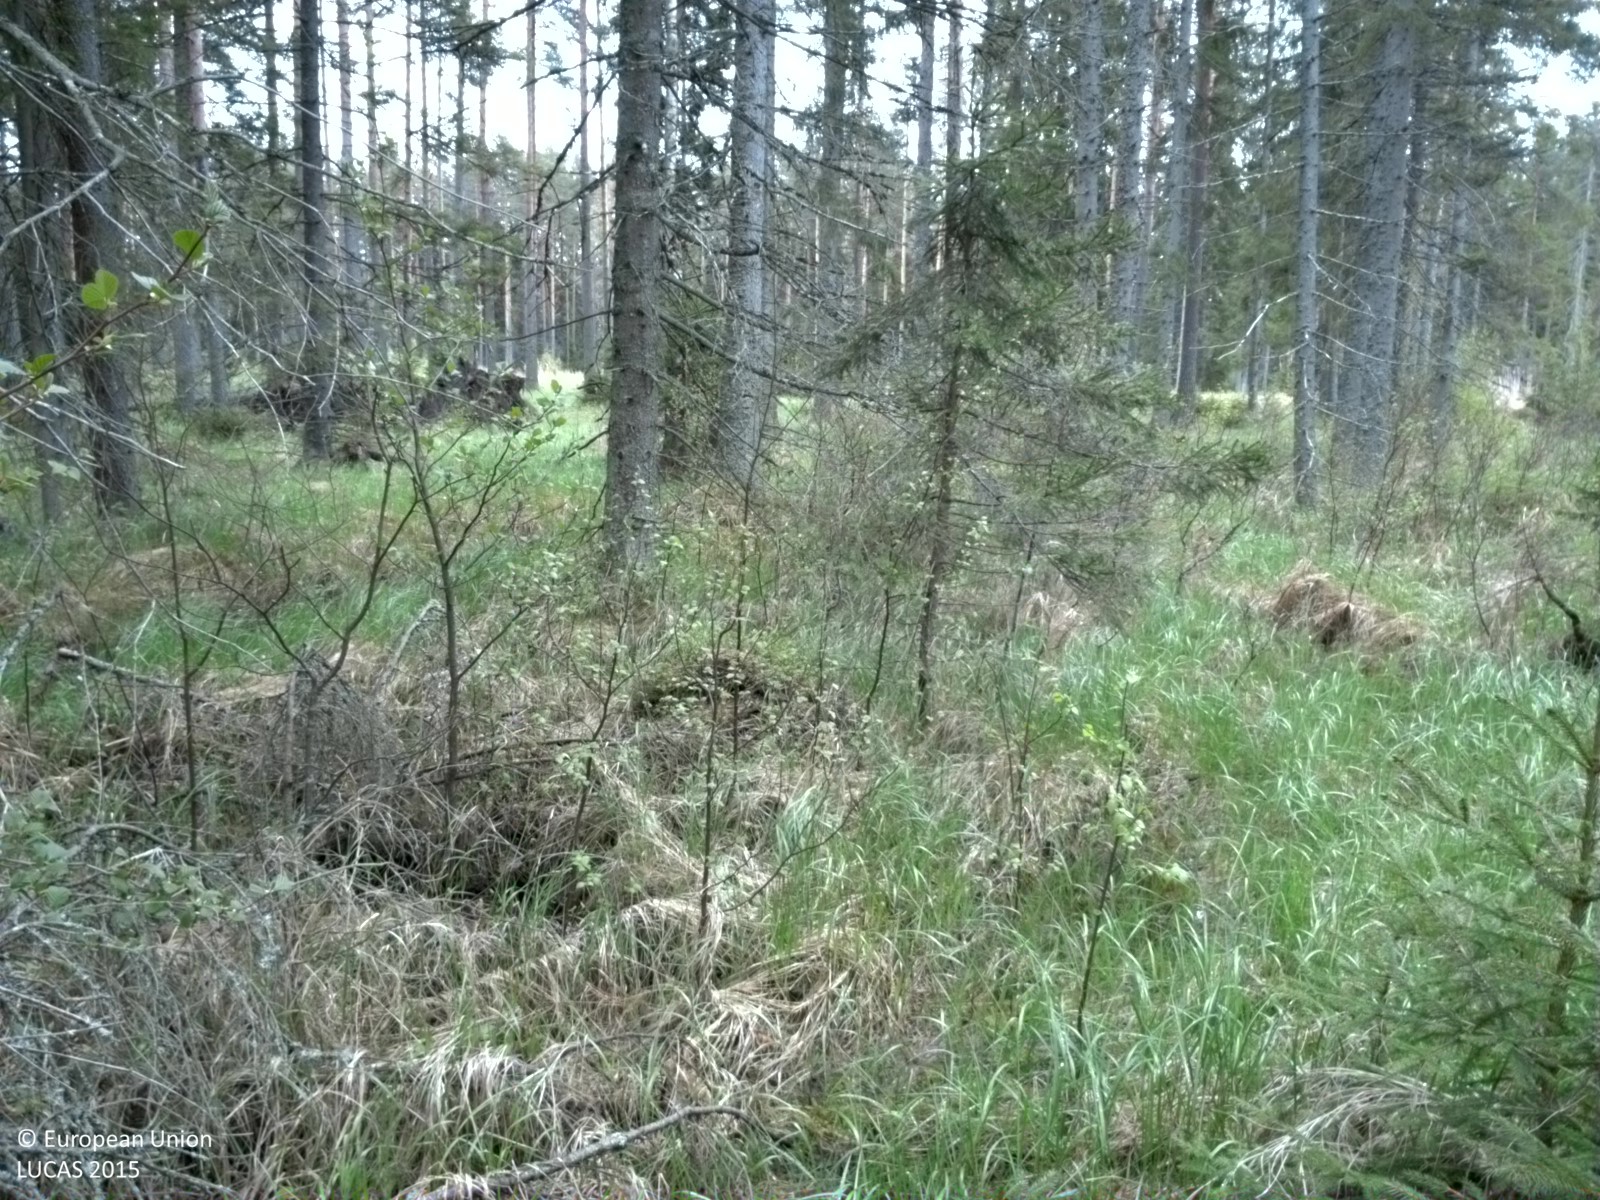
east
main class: Woodland
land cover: Spruce dominated coniferous woodland
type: boreal forest
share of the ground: > 75 %
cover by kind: coniferous forest trees 75 %, herbaceous plants 15 %, broadleaved forest trees 5 %
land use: Forestry
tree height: > 5 m
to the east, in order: Spruce dominated coniferous woodland; Ditches and canals; Spruce dominated coniferous woodland; Pine dominated coniferous woodland; Paved roads, cycling and walking lanes; Ditches and canals; Shrubland with sparse tree cover; Pine dominated coniferous woodland
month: May
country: SE
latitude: 60.2255
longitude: 17.9916
